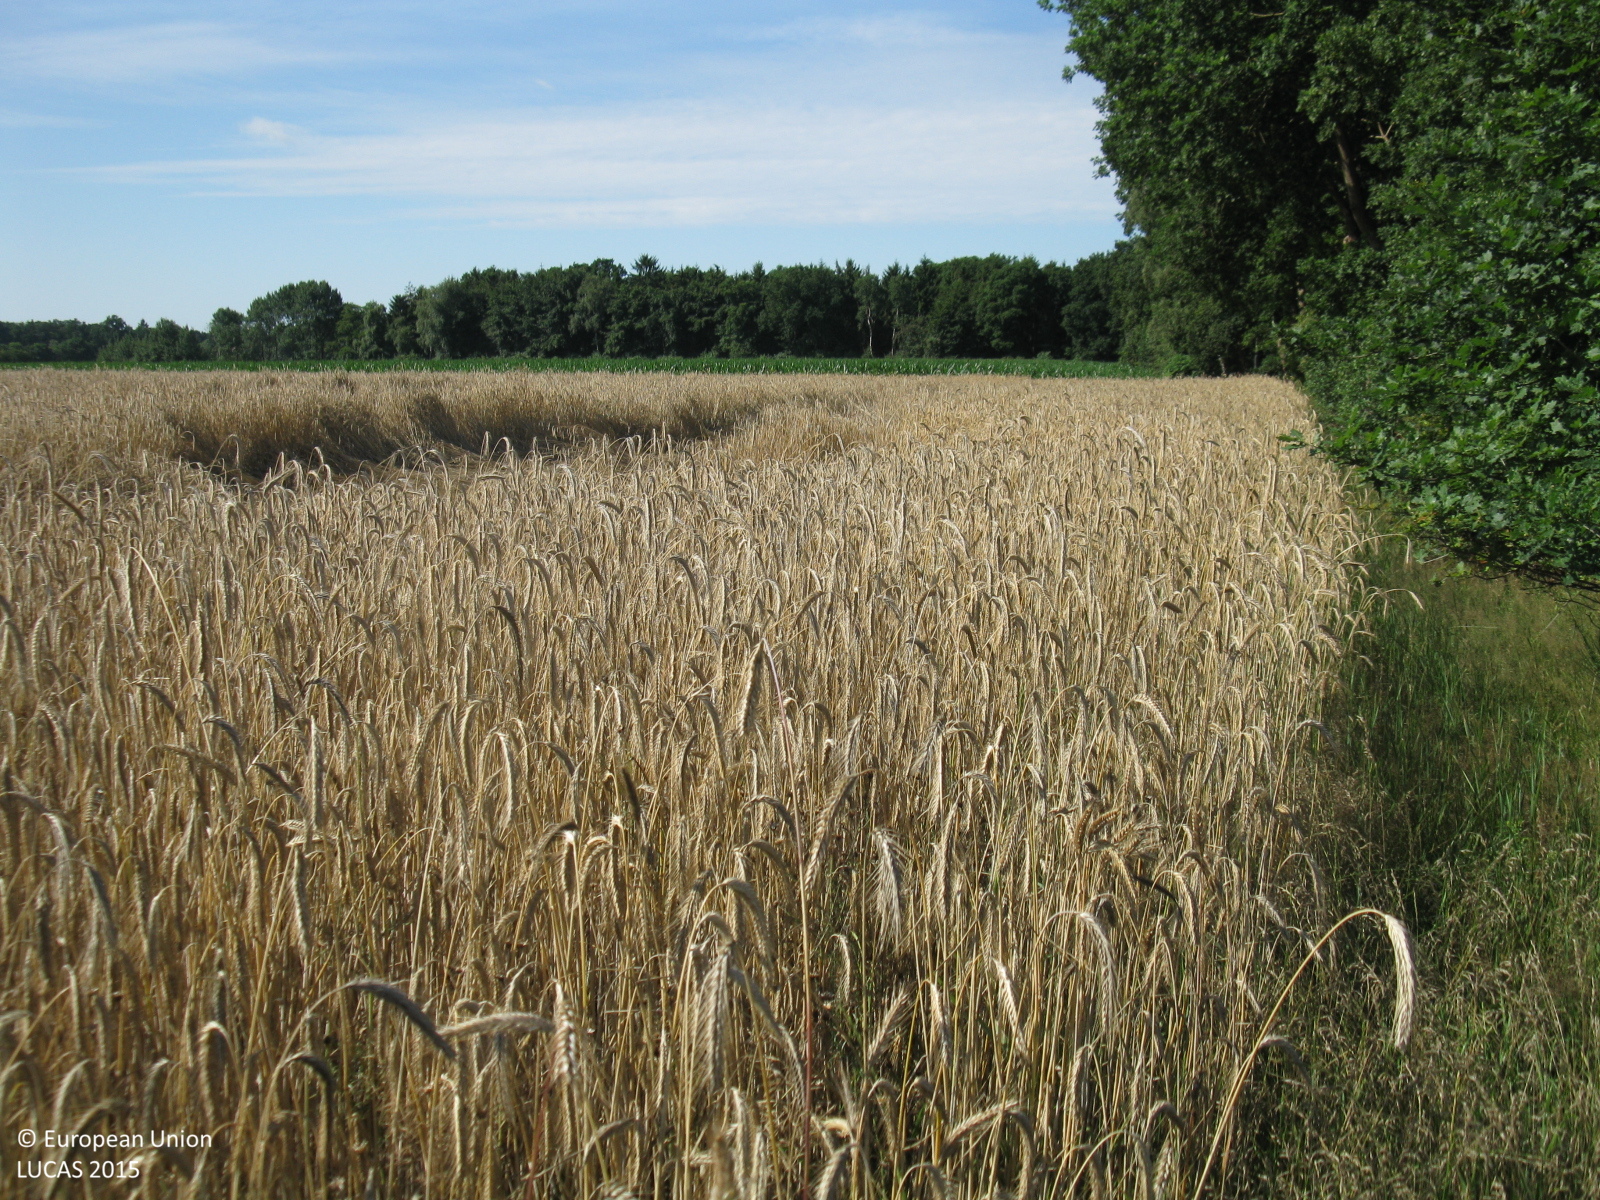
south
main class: Cropland
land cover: Triticale
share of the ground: > 75 %
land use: Agriculture (excluding fallow land and kitchen gardens)
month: July
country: DE
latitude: 52.9882
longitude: 7.9002
